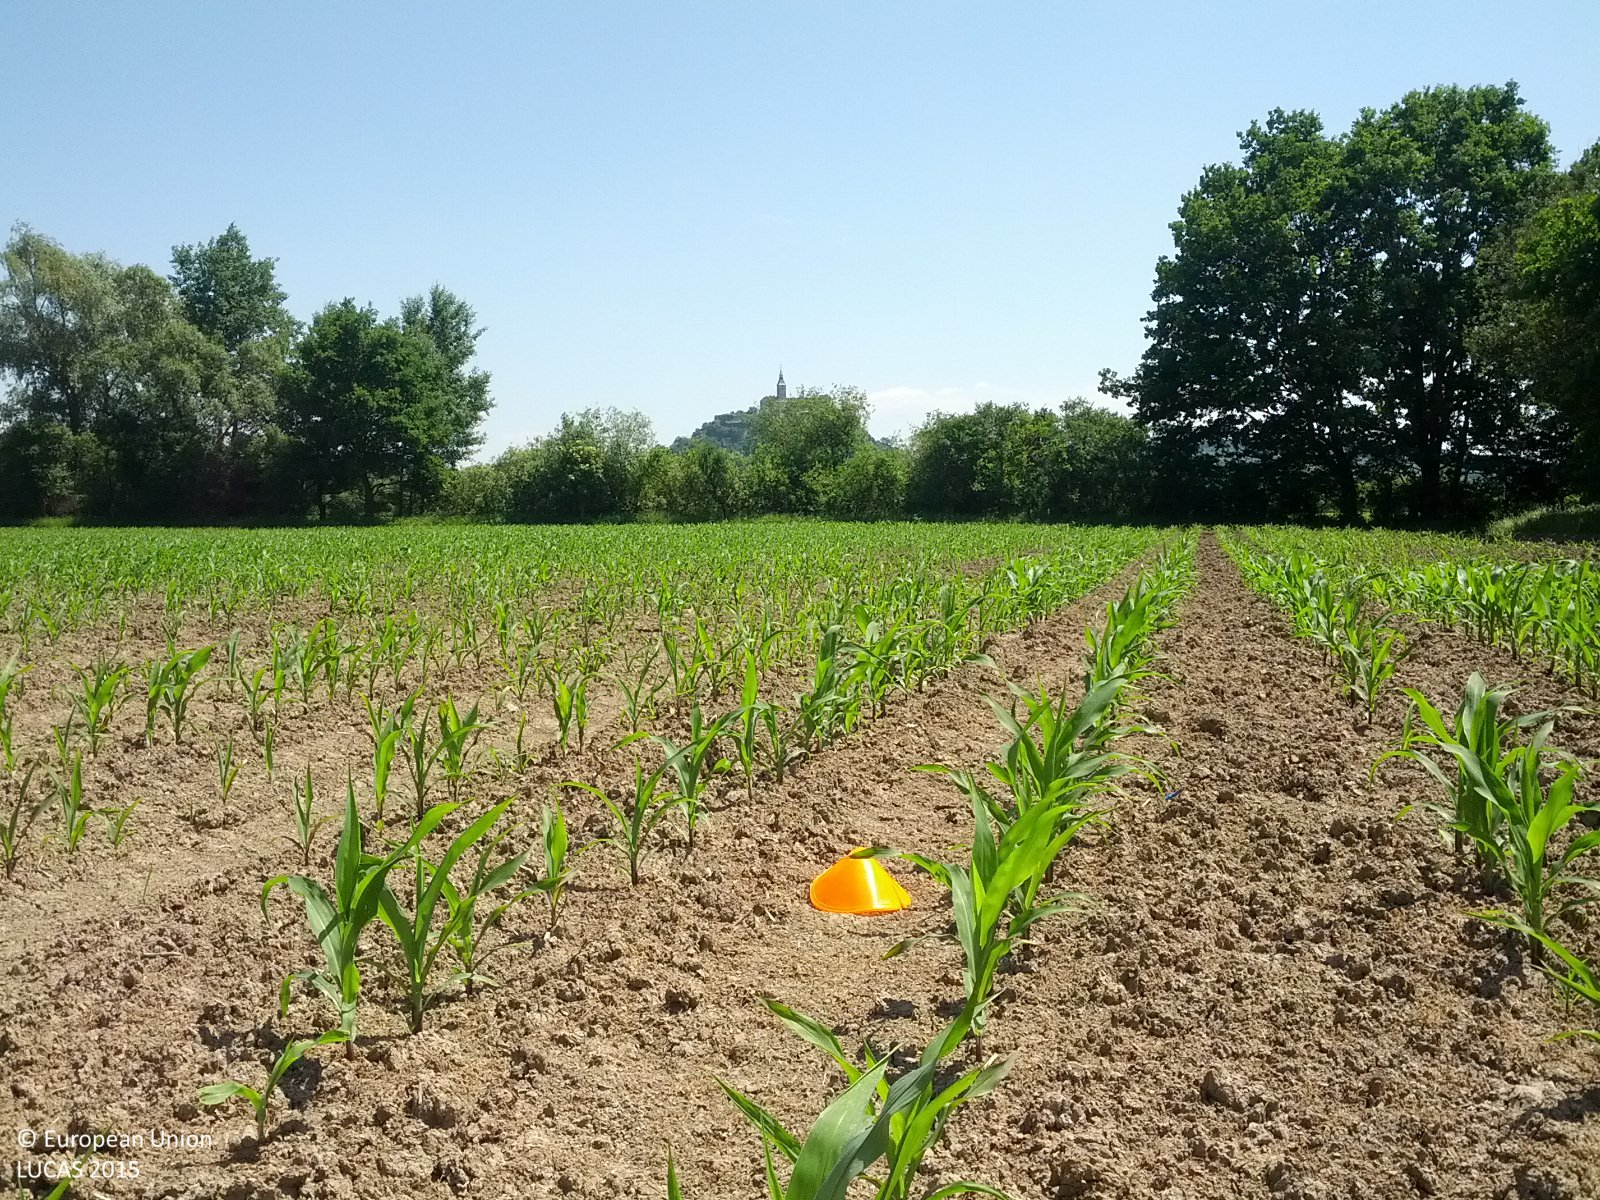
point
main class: Cropland
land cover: Maize
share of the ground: 10 - 25 %
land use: Agriculture (excluding fallow land and kitchen gardens)
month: June
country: AT
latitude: 47.0679
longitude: 16.3094
